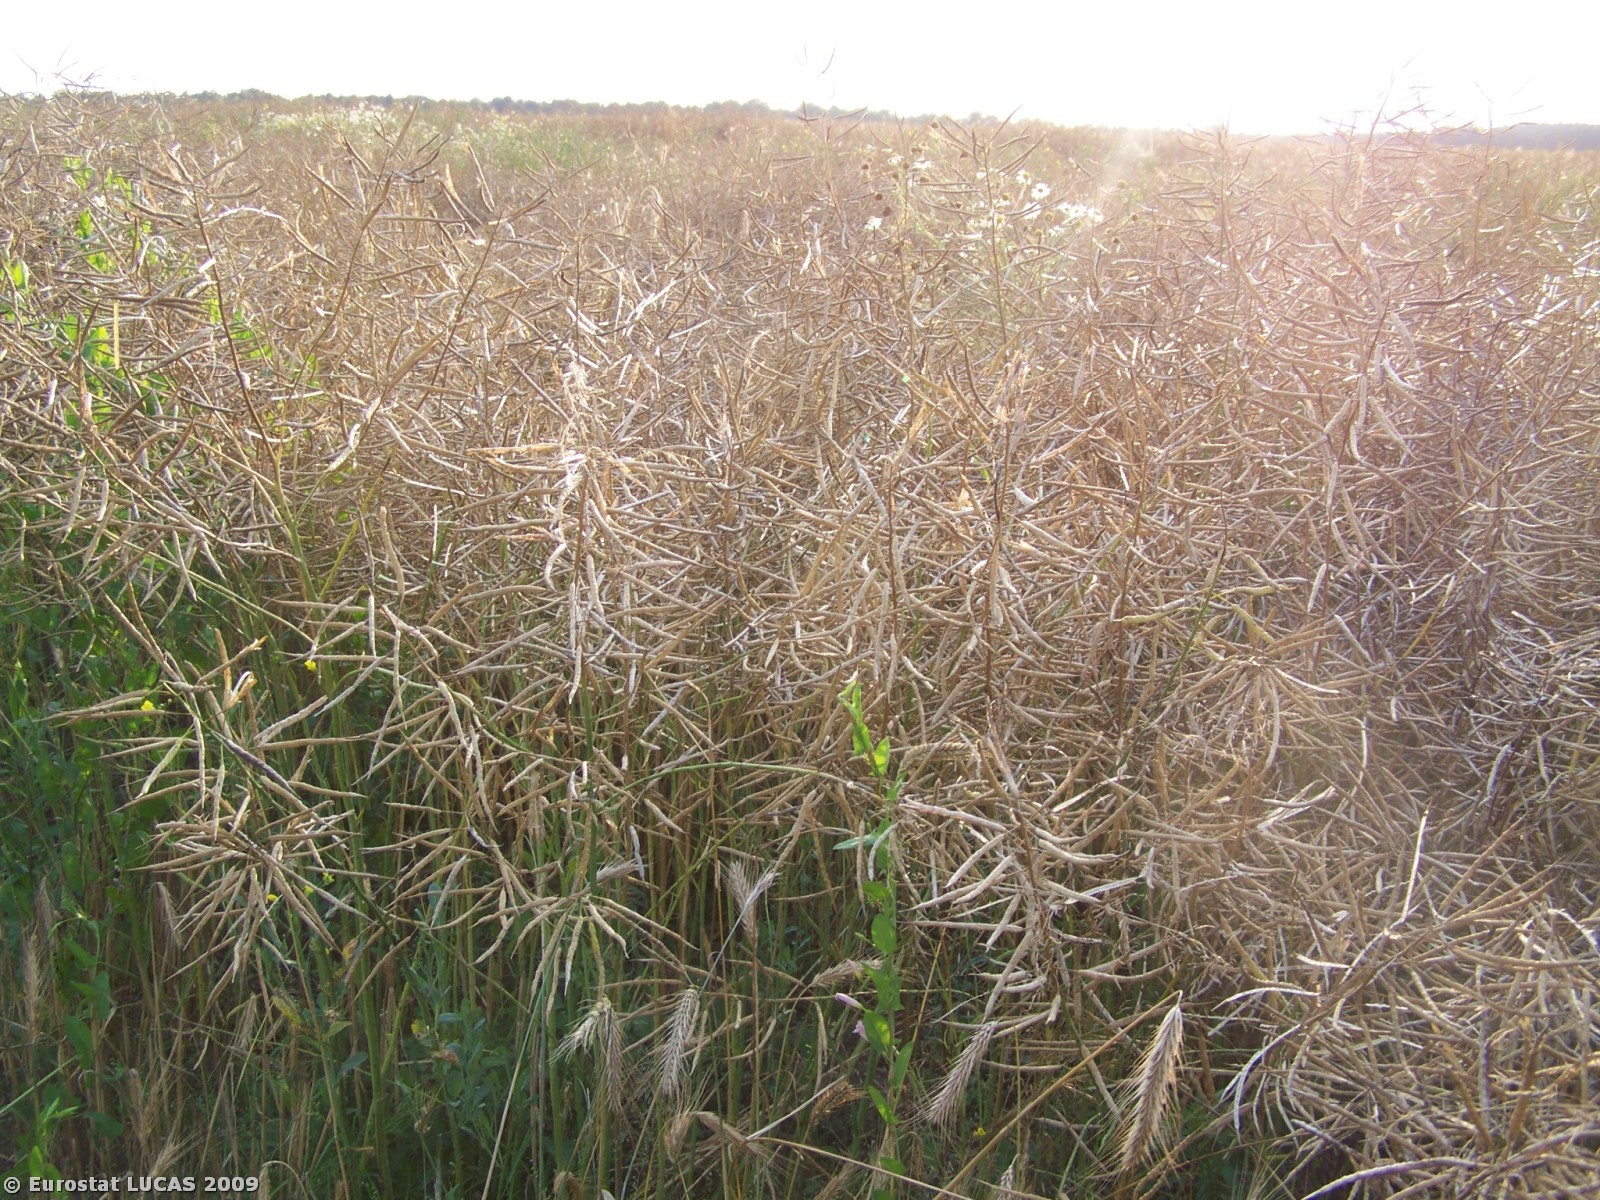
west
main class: Cropland
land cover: Rape and turnip rape
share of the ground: > 75 %
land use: Agriculture (excluding fallow land and kitchen gardens)
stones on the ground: < 10 %
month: July
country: PL
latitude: 51.4699
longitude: 22.0511
